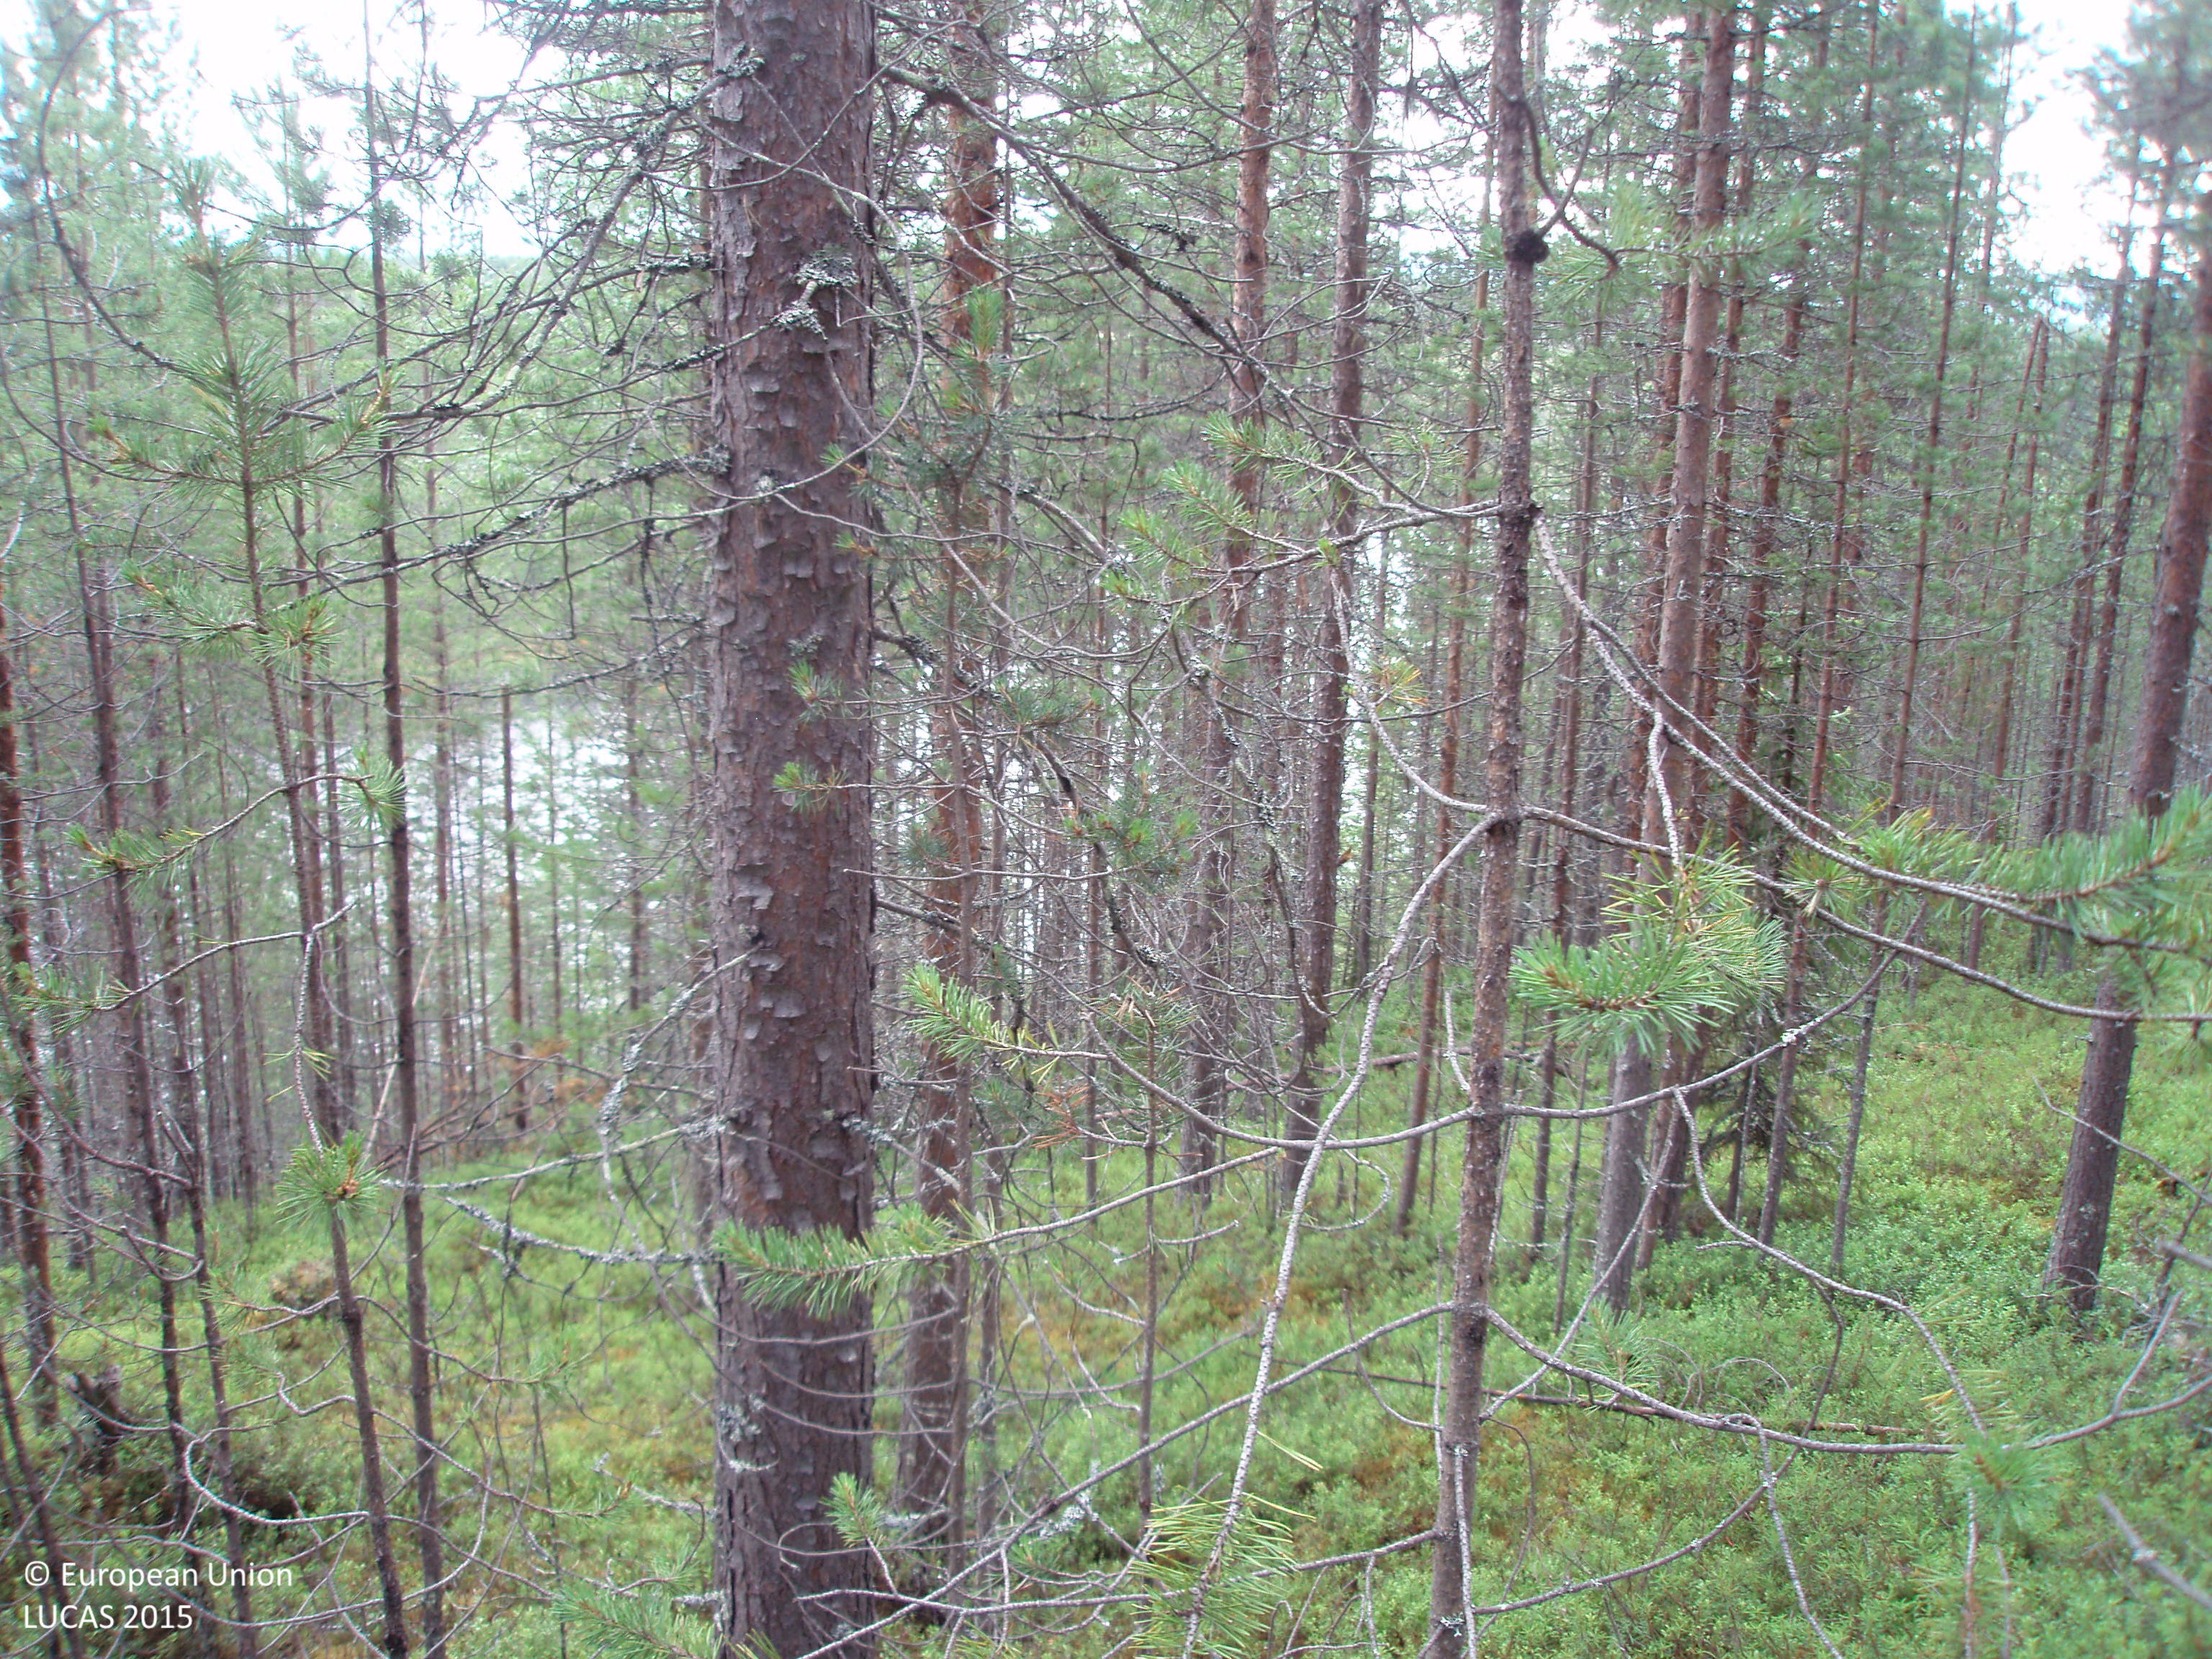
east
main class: Woodland
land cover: Pine dominated coniferous woodland
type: boreal forest
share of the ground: 50 - 75 %
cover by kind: coniferous forest trees 70 %, shrubs 30 %
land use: Forestry
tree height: > 5 m
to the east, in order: Pine dominated coniferous woodland; Inland fresh water bodies; Peatbogs; Pine dominated coniferous woodland; Peatbogs
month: July
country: FI
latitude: 66.9555
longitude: 27.8595
